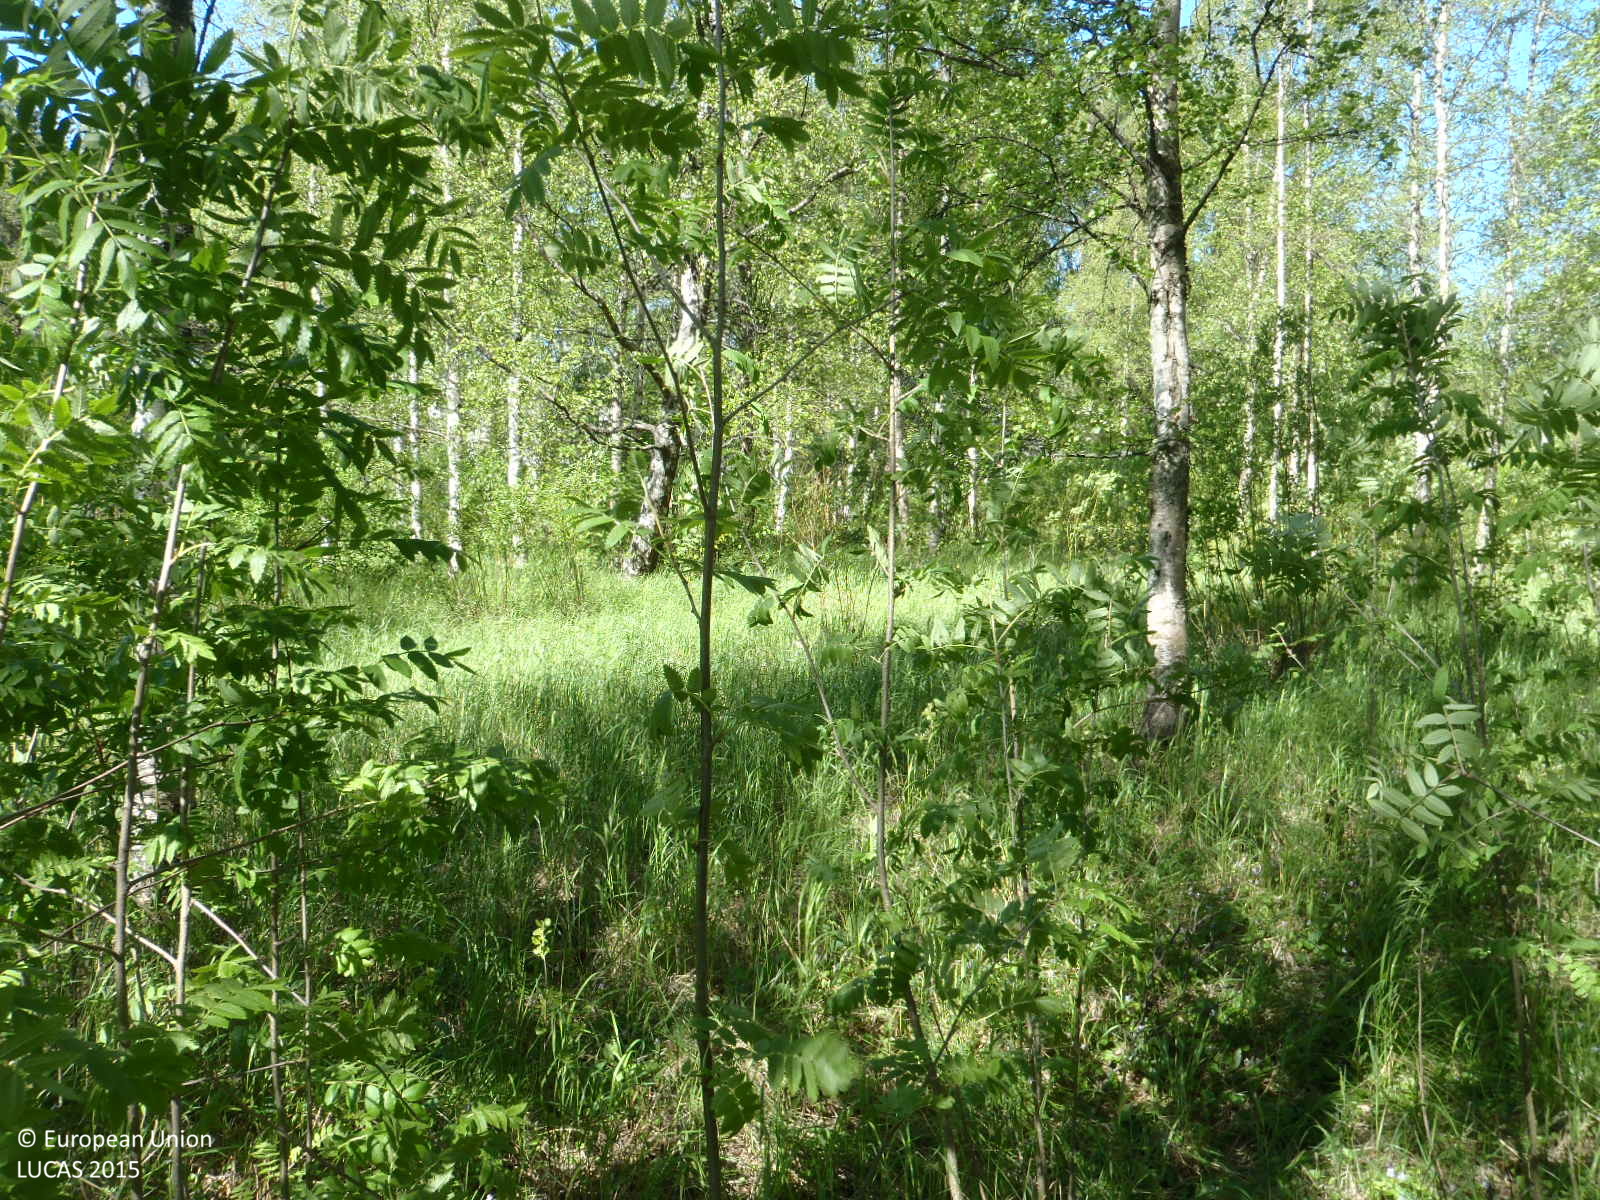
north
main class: Woodland
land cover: Other mixed woodland
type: boreal forest
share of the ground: 50 - 75 %
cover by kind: broadleaved forest trees 40 %, herbaceous plants 30 %, coniferous forest trees 20 %, shrubs 10 %
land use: Amenities, museums, leisure
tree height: > 5 m
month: June
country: FI
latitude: 64.9983
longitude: 25.5001
